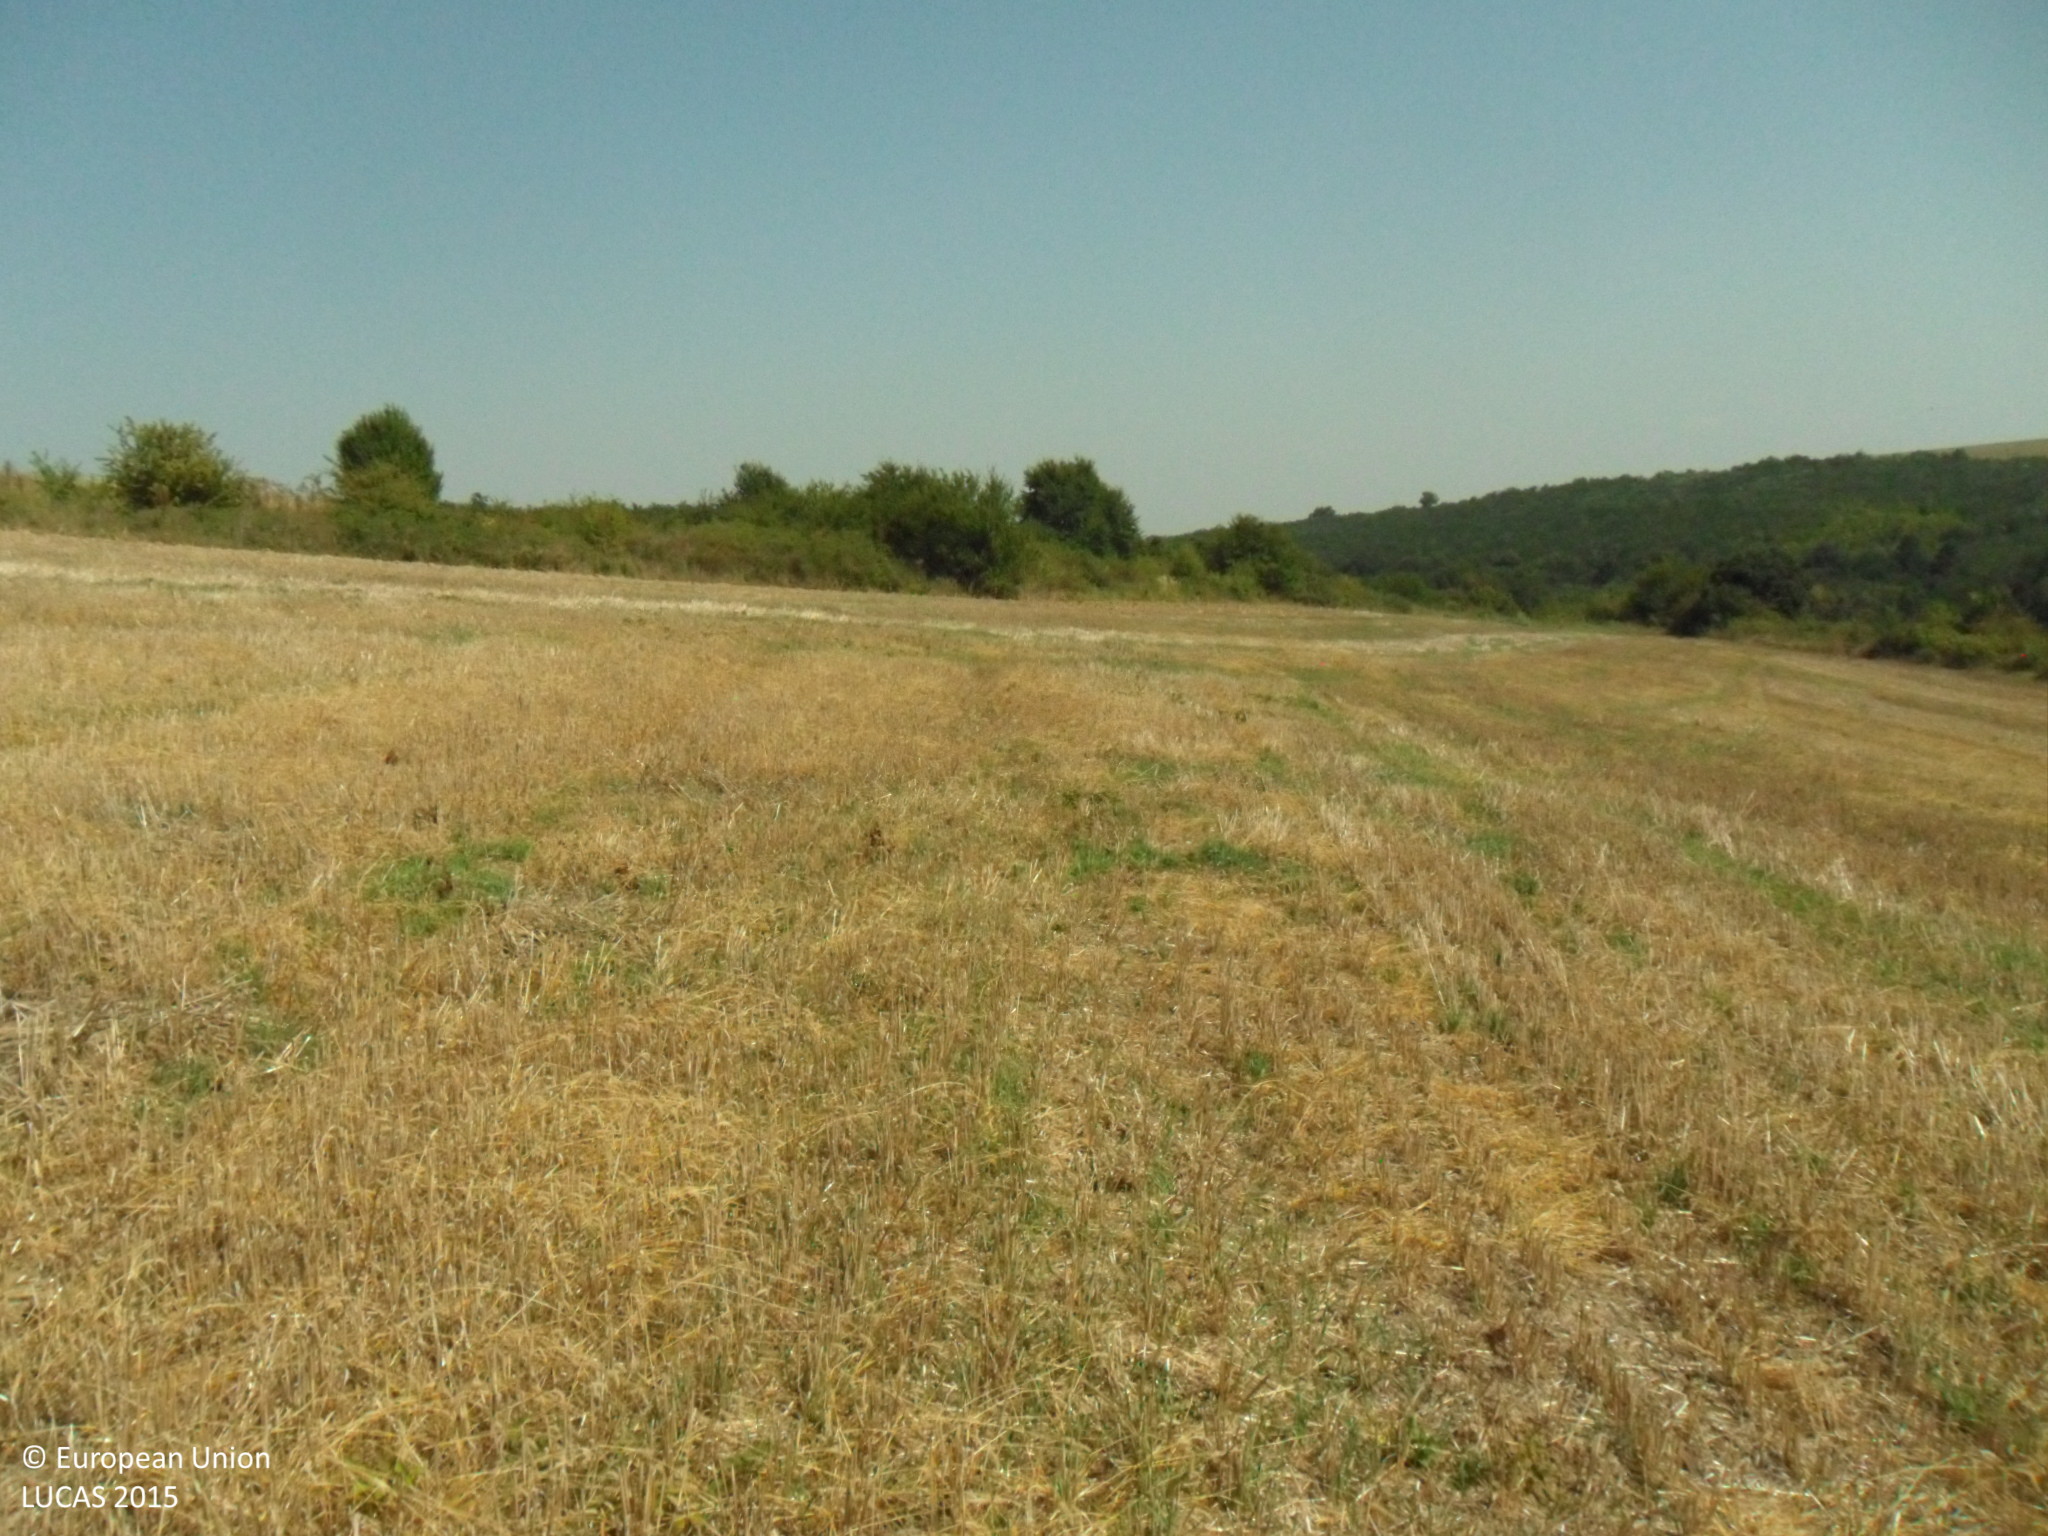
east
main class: Cropland
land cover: Common wheat
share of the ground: 25 - 50 %
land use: Agriculture (excluding fallow land and kitchen gardens)
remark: Harvested field
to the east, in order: Common wheat; Shrubland without tree cover; Paved roads, cycling and walking lanes; Shrubland without tree cover; Grass margins; Common wheat
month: September
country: BG
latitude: 43.5819
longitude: 26.0836
